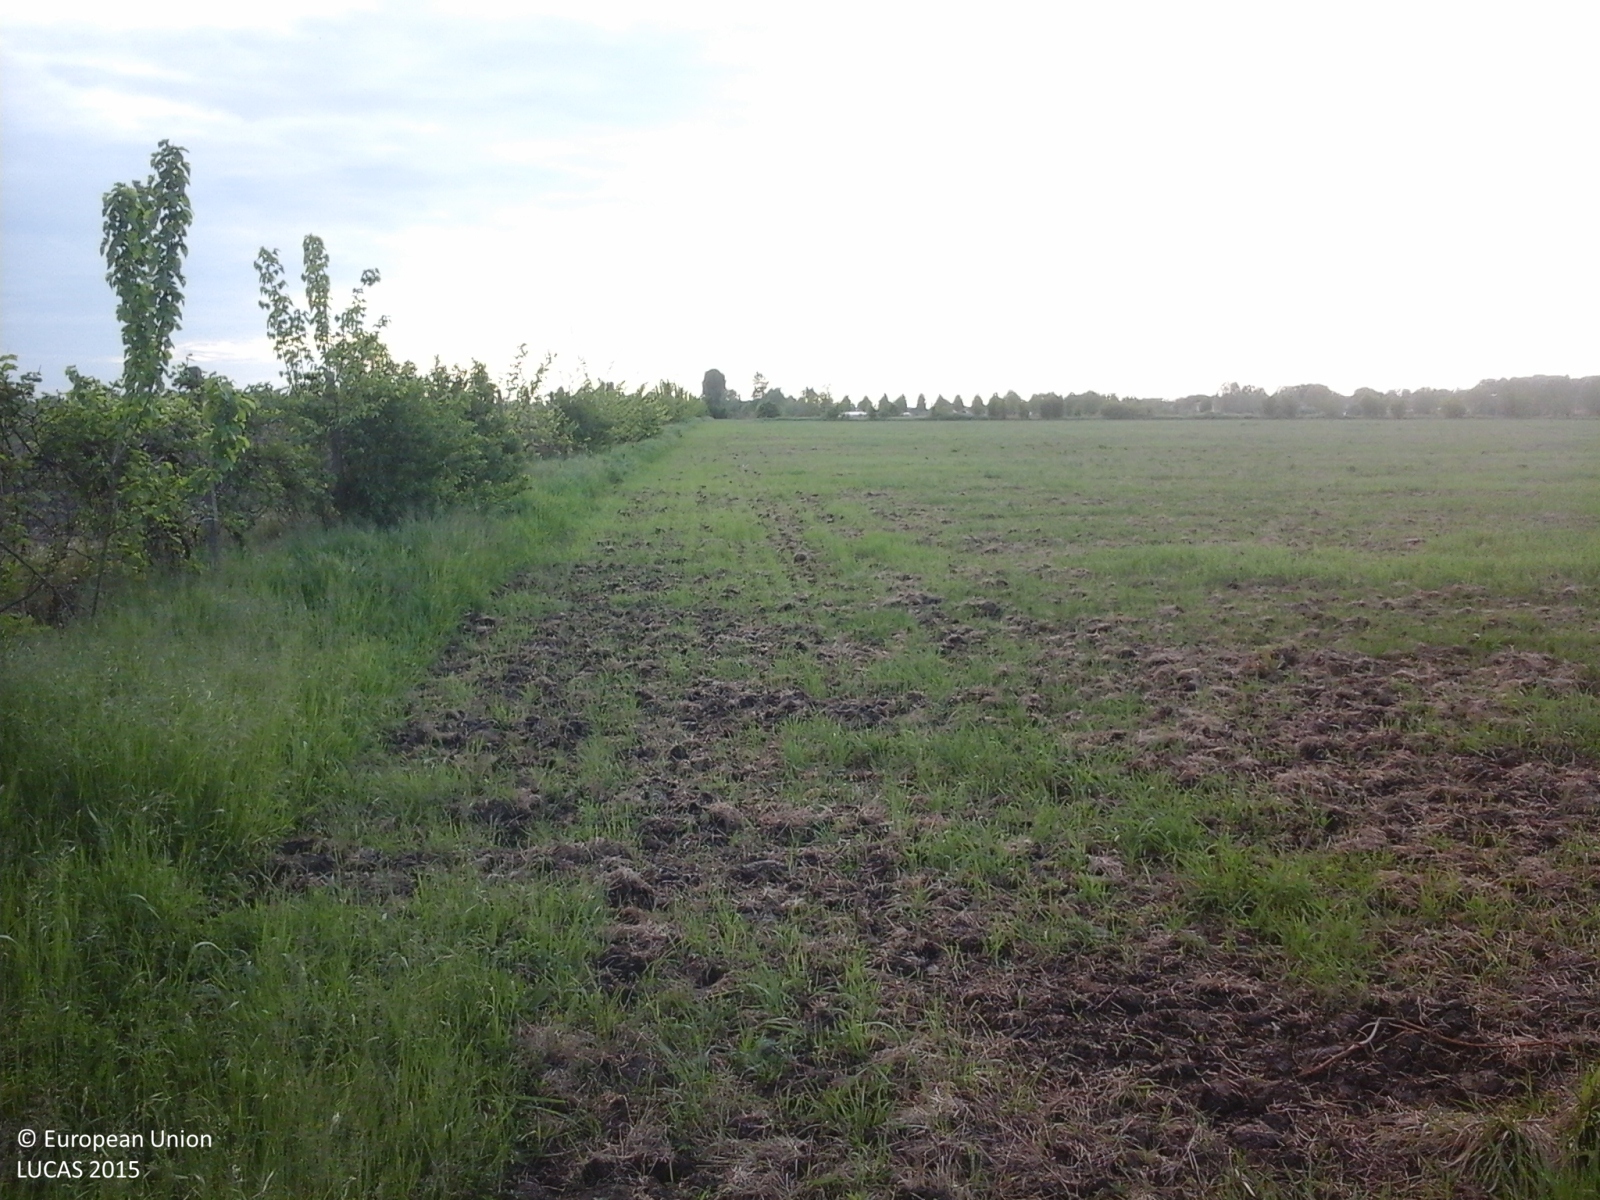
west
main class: Cropland
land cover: Arable land (only in case pi)
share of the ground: > 75 %
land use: Agriculture (excluding fallow land and kitchen gardens)
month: April
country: IT
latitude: 45.0939
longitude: 11.7123
